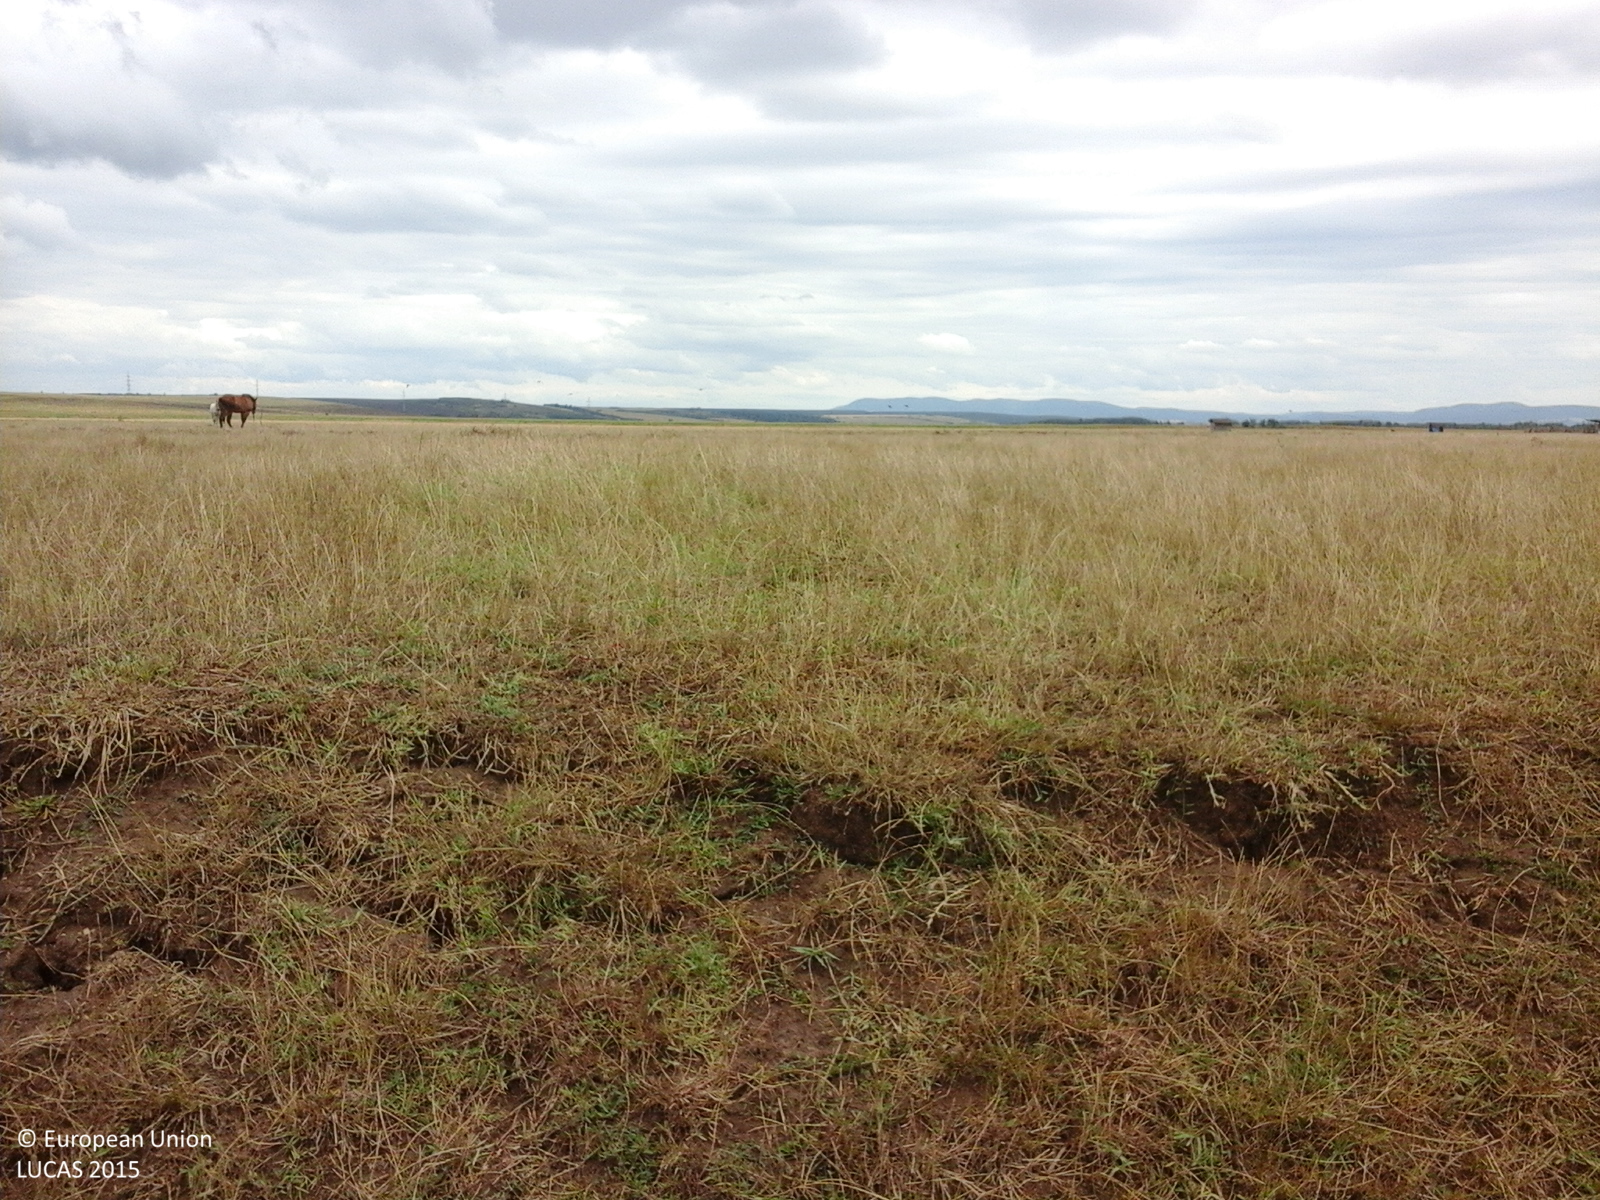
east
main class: Grassland
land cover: Grassland without tree/shrub cover
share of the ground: > 75 %
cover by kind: herbaceous plants 100 %
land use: Agriculture (excluding fallow land and kitchen gardens)
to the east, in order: Ditches and canals; Grassland without tree/shrub cover
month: August
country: RO
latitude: 45.4528
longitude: 21.5278
